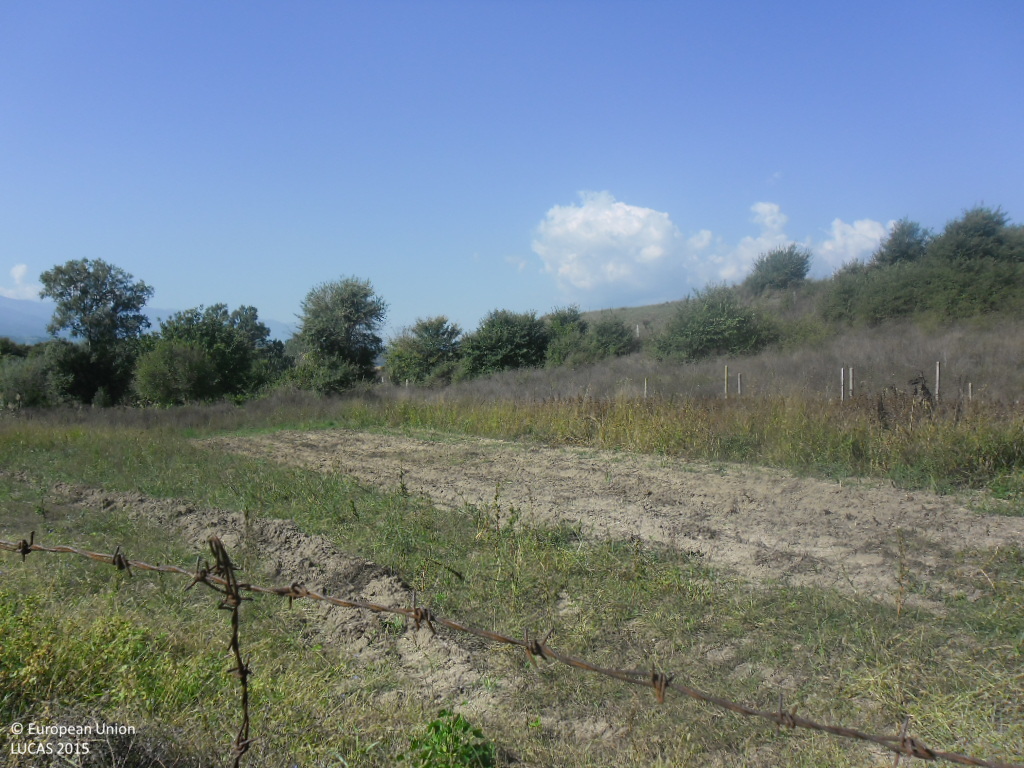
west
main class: Grassland
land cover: Grassland without tree/shrub cover
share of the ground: > 75 %
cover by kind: herbaceous plants 100 %
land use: Agriculture (excluding fallow land and kitchen gardens)
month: October
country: BG
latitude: 41.4379
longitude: 23.3417
